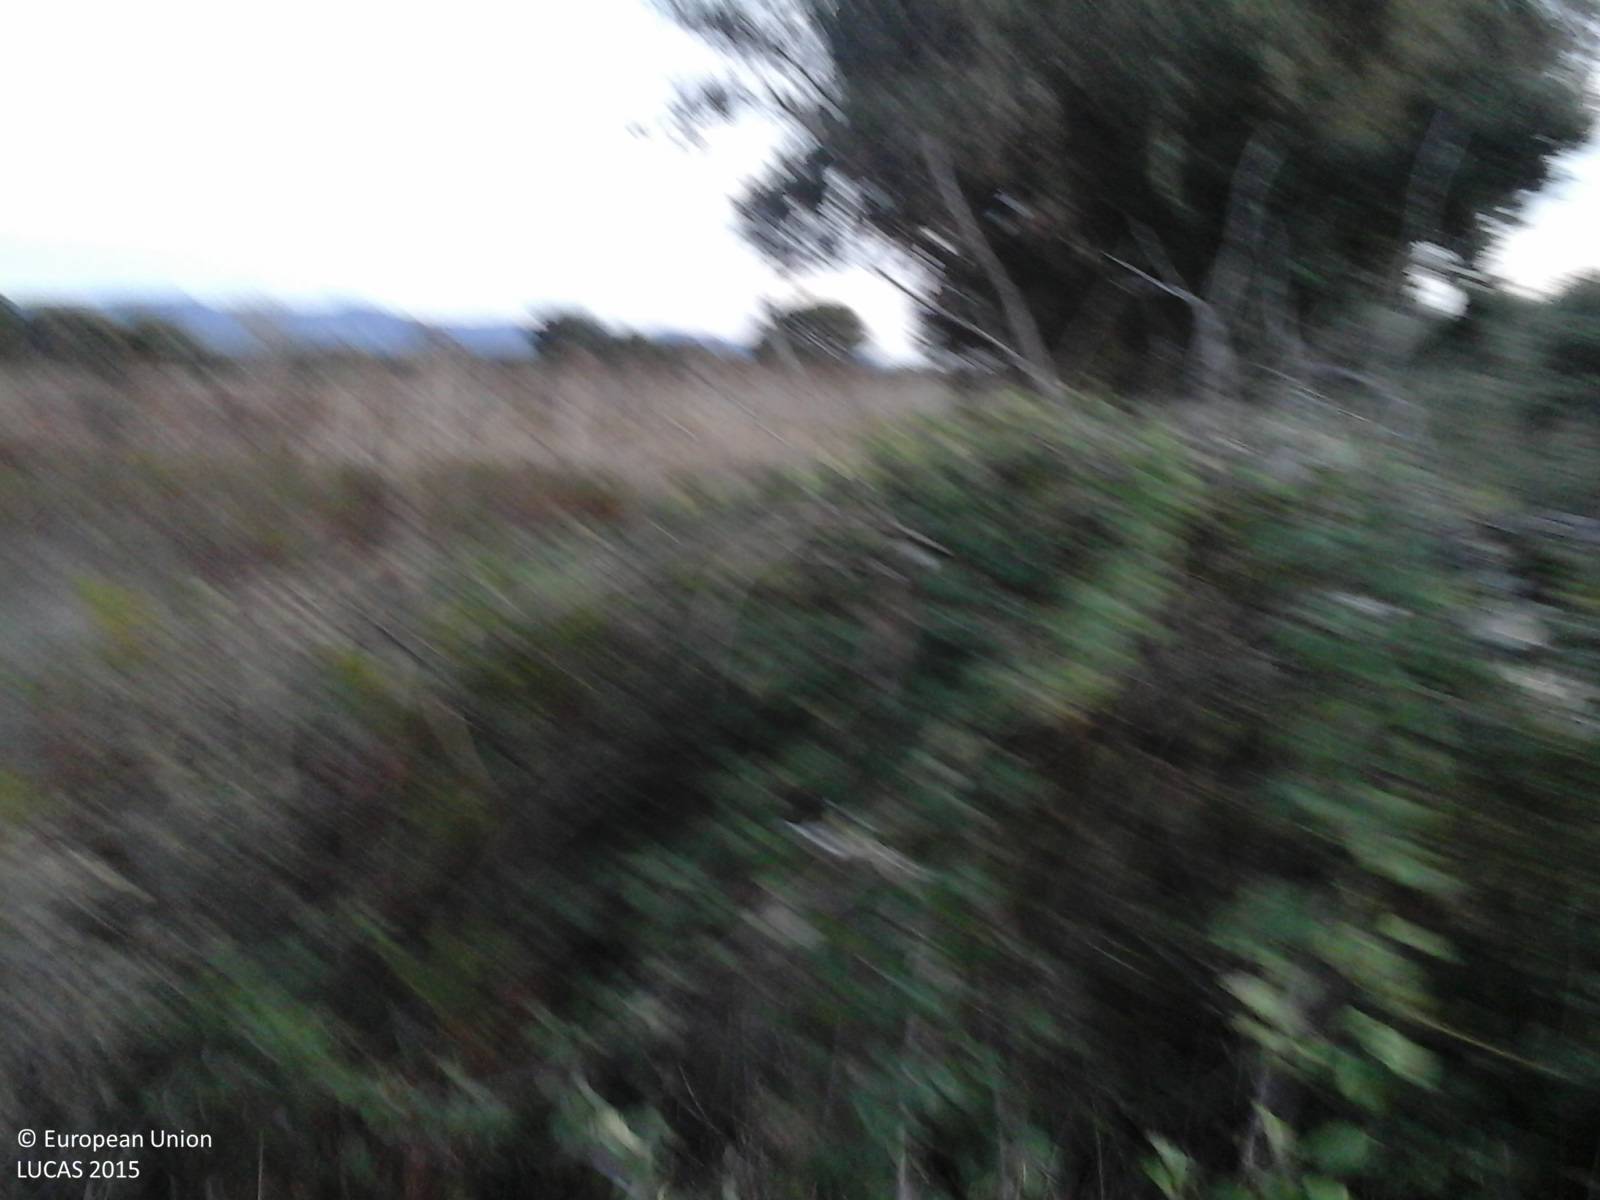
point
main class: Grassland
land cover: Spontaneously vegetated surfaces
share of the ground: > 75 %
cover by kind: herbaceous plants 100 %
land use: Agriculture (excluding fallow land and kitchen gardens)
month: October
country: IT
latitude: 40.2752
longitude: 8.5843
